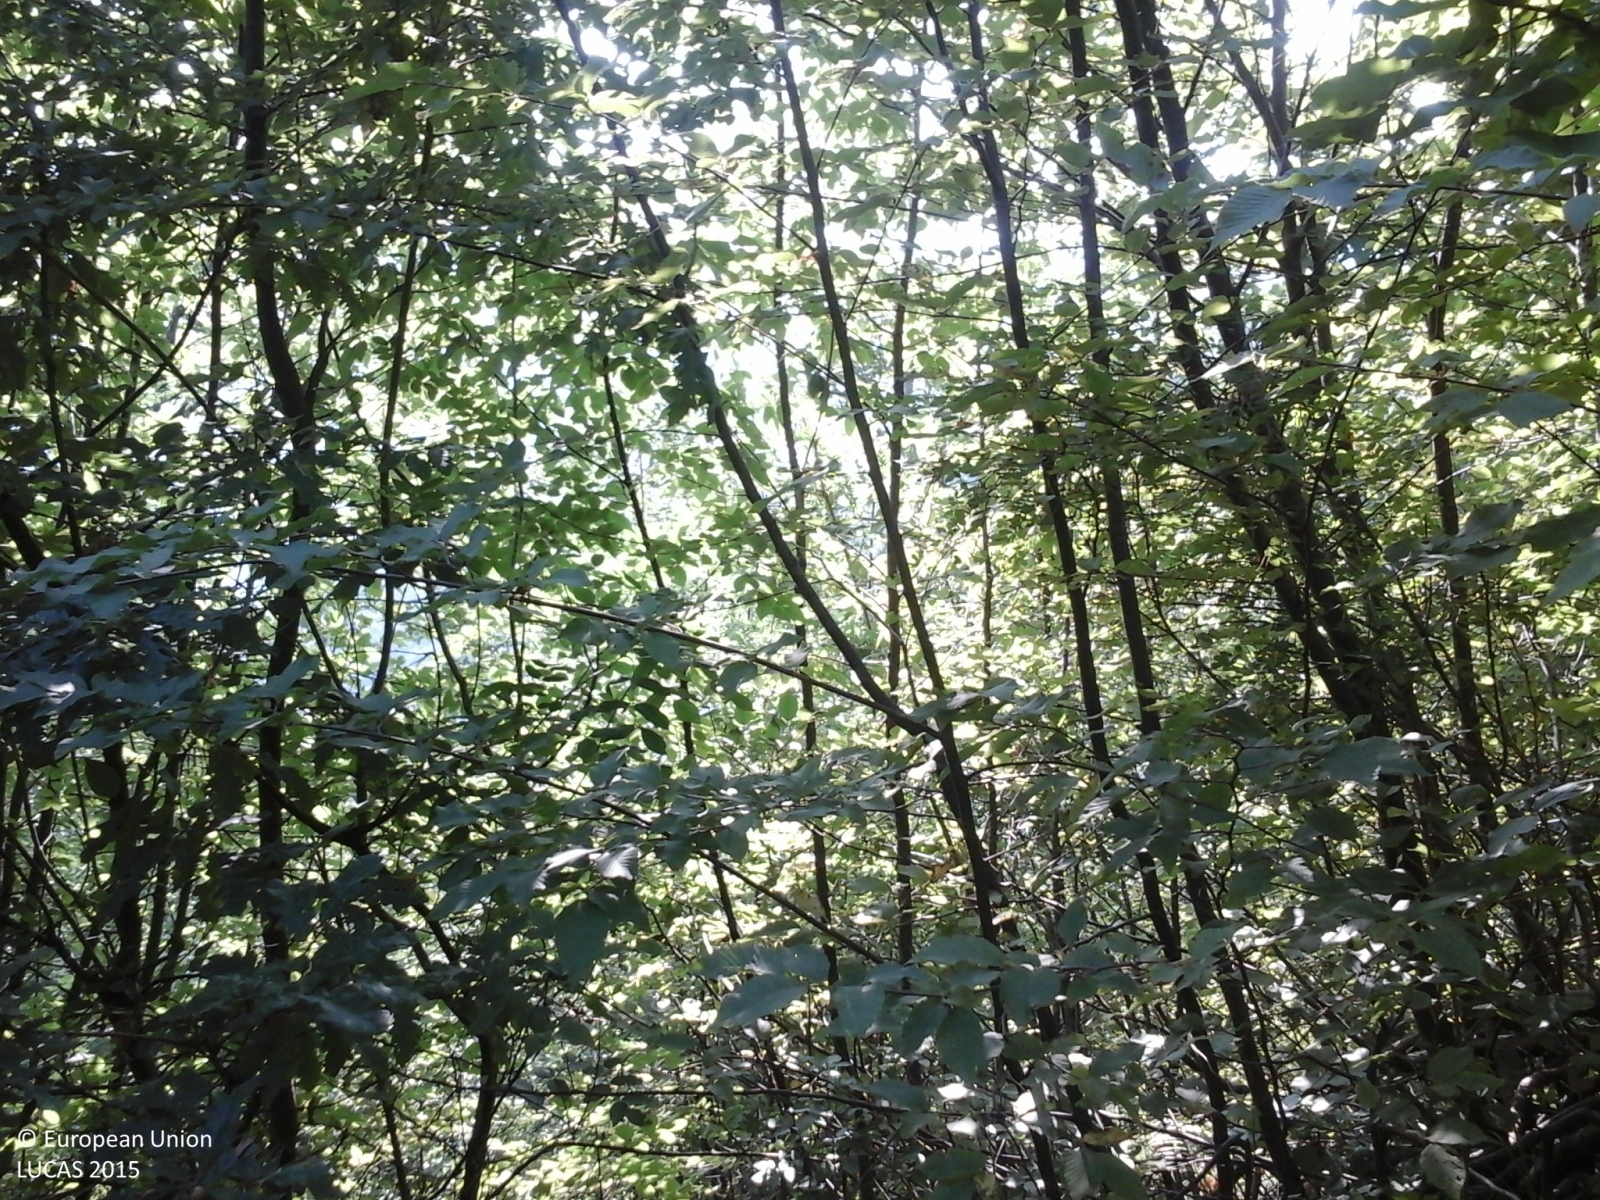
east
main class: Woodland
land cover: Broadleaved woodland
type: thermophilous deciduous forest
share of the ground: > 75 %
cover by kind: broadleaved forest trees 100 %
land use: Forestry
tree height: > 5 m
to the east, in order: Broadleaved woodland; Tracks; Broadleaved woodland; Tracks; Broadleaved woodland
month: August
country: IT
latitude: 43.7494
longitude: 12.2174
